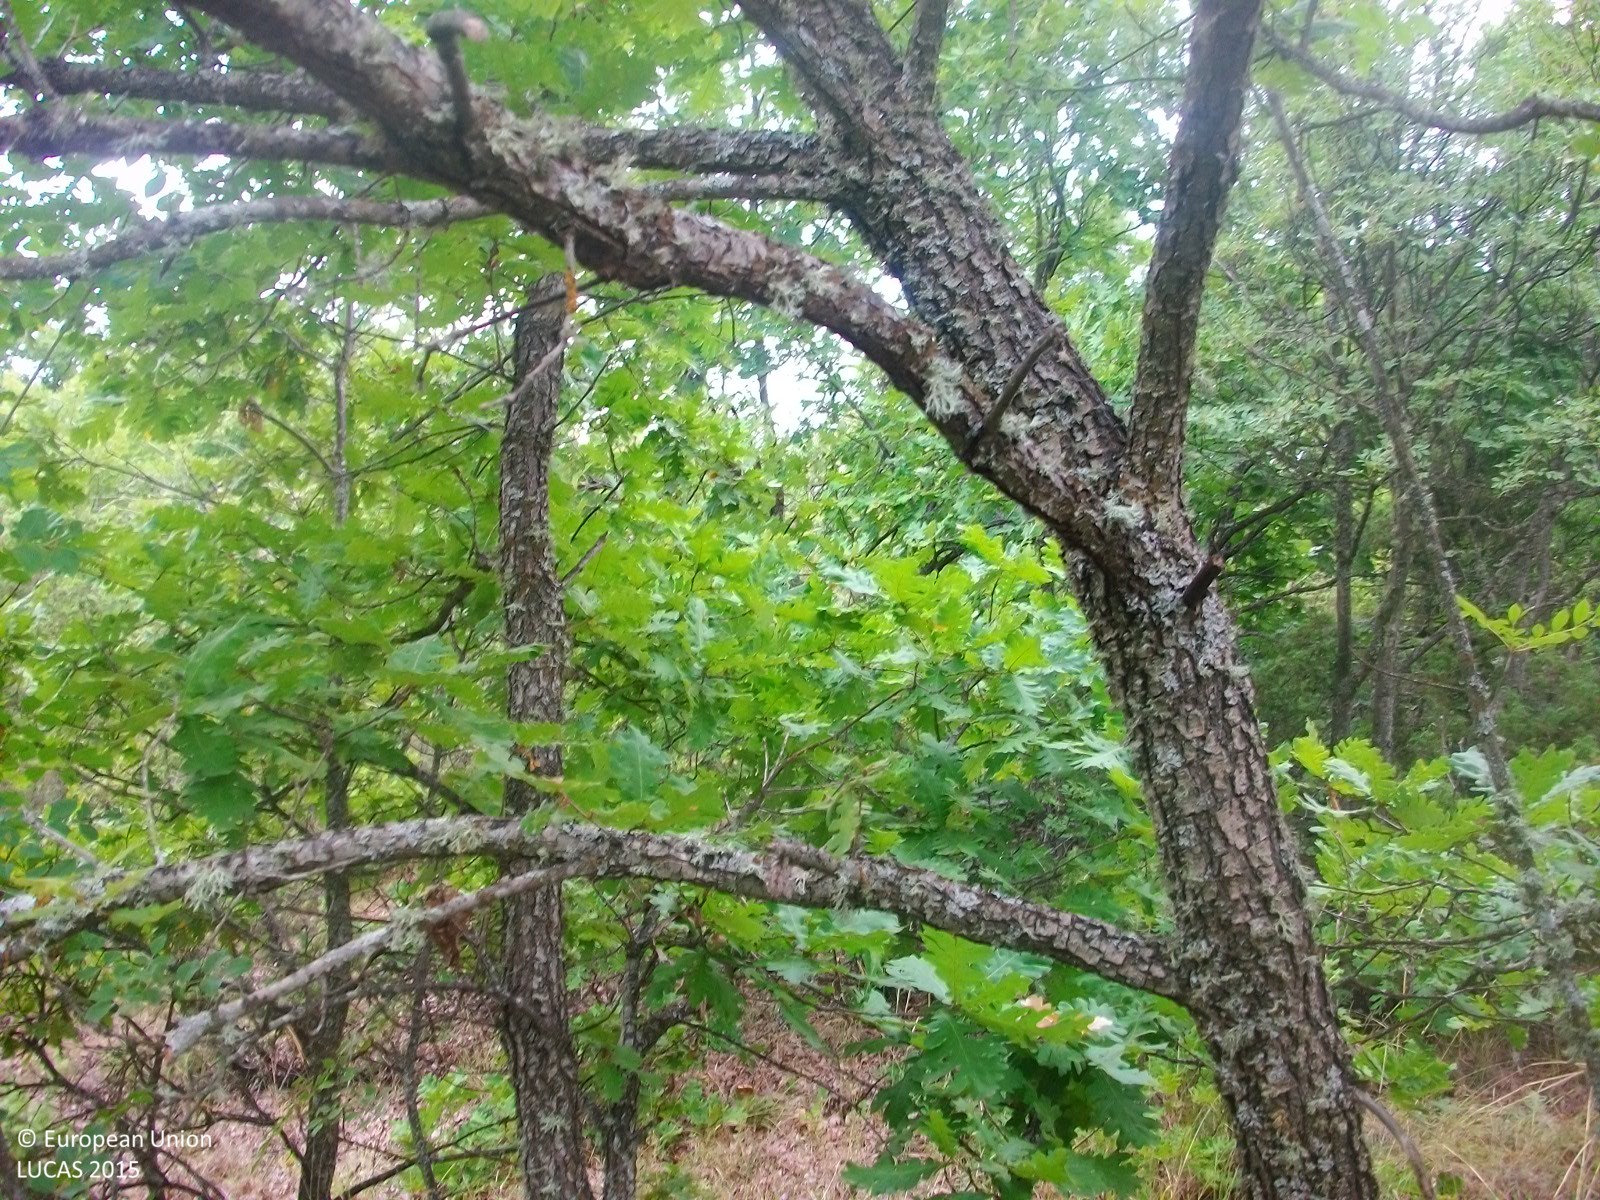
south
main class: Woodland
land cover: Broadleaved woodland
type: thermophilous deciduous forest
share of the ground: > 75 %
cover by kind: broadleaved forest trees 90 %, herbaceous plants 10 %
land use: Forestry
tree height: > 5 m
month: August
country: GR
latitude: 41.3374
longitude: 26.2140
